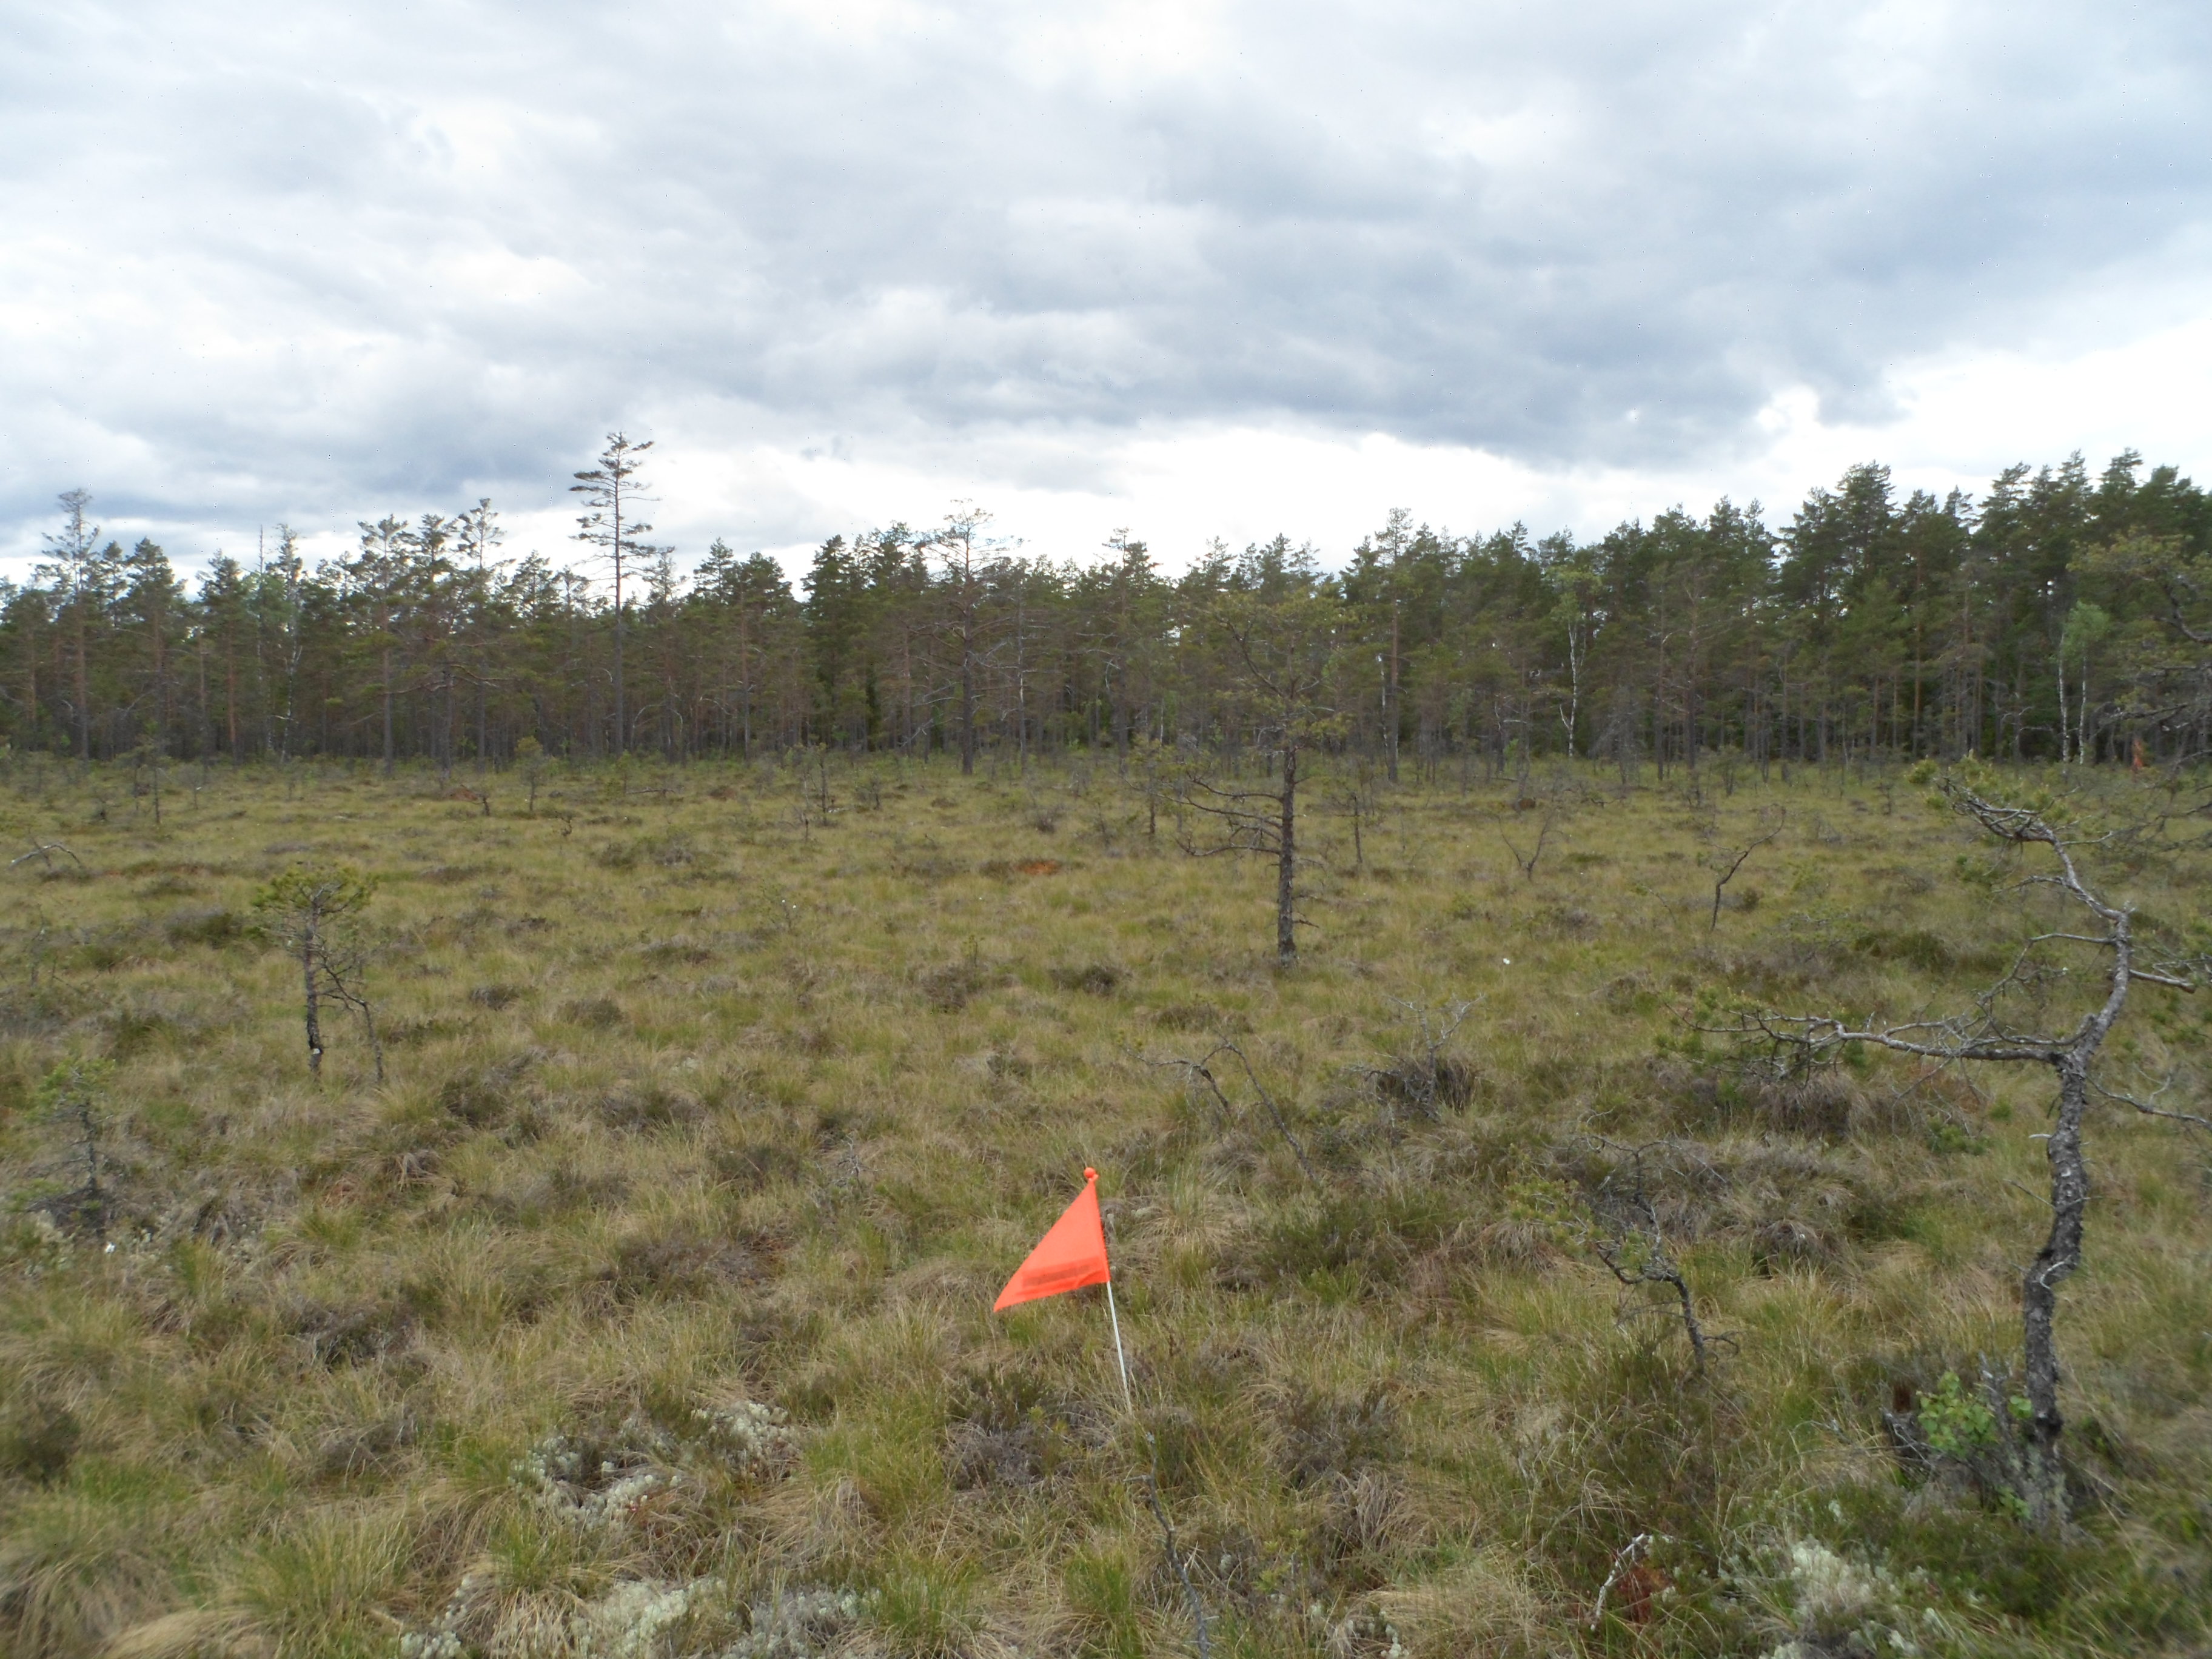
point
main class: Woodland
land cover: Pine dominated coniferous woodland
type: boreal forest
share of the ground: 10 - 25 %
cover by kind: herbaceous plants 40 %, lichens and mosses 35 %, coniferous forest trees 15 %, shrubs 10 %
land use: Amenities, museums, leisure
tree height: < 5 m
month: June
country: SE
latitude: 57.3908
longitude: 14.4048
